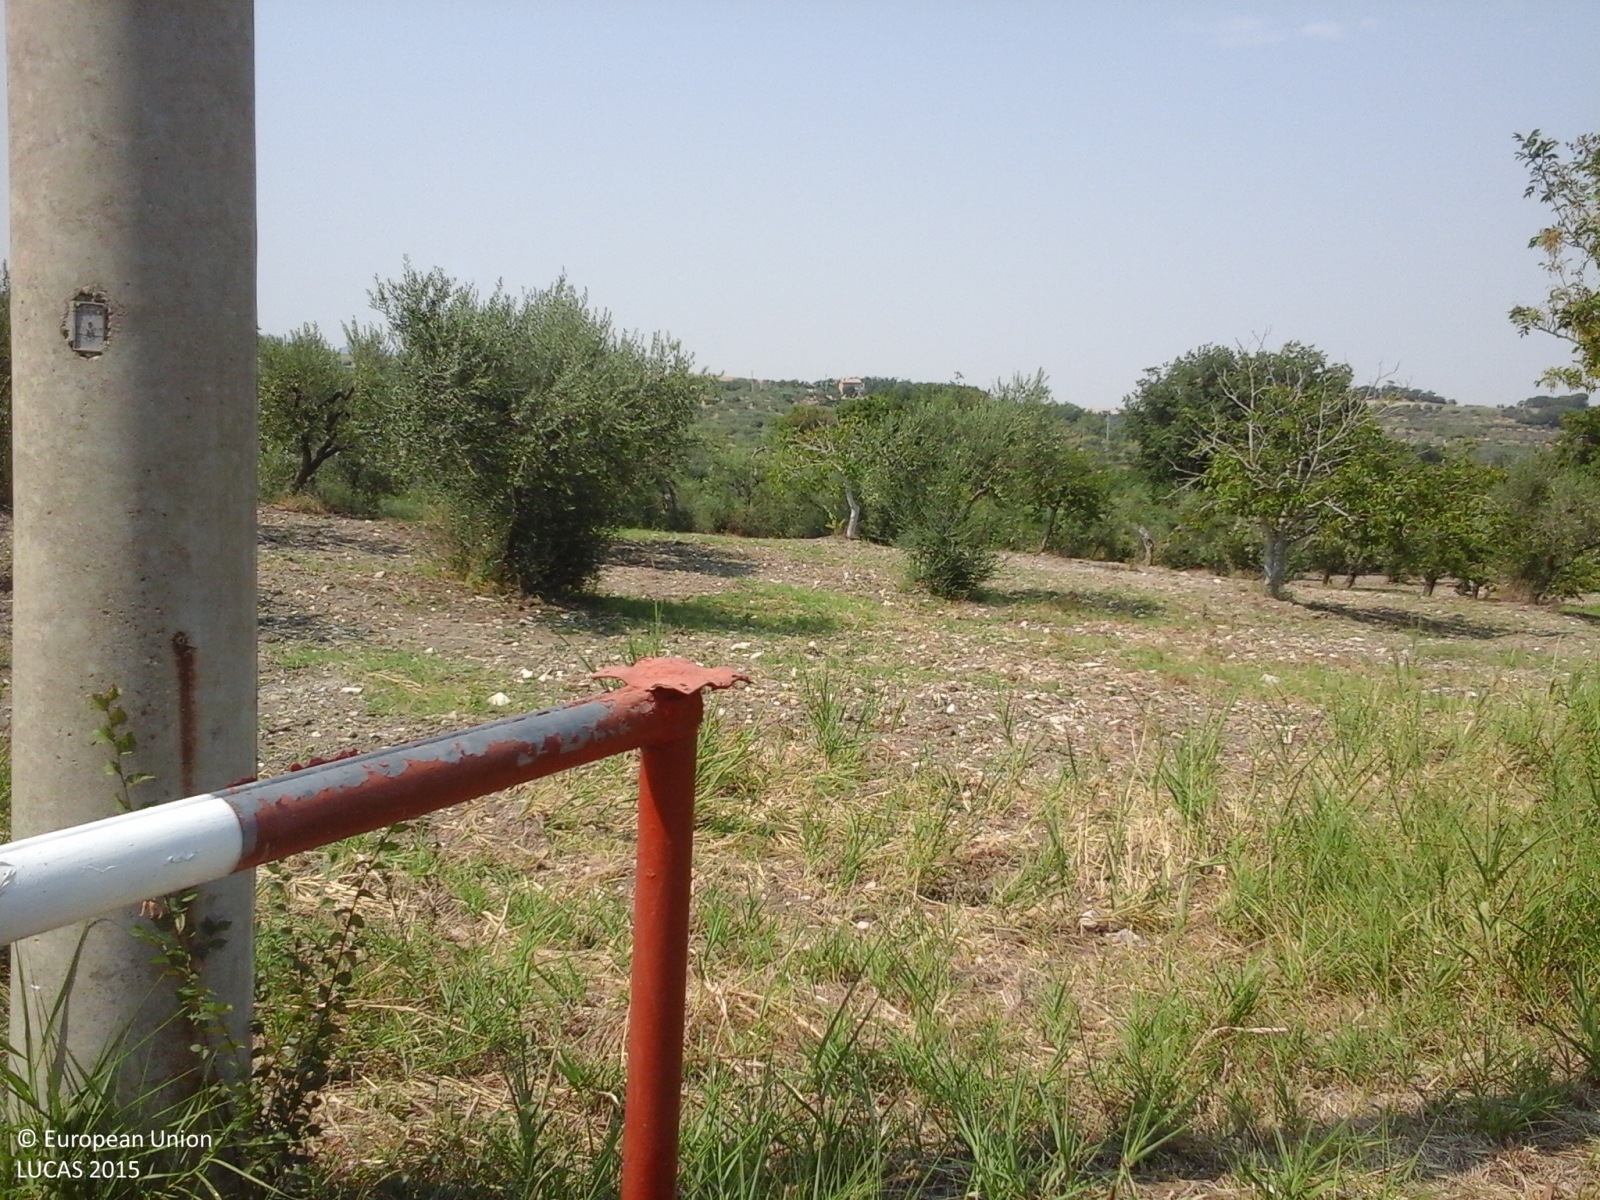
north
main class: Cropland
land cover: Olive groves
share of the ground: 50 - 75 %
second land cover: Spontaneously vegetated surfaces
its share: > 75 %
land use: Agriculture (excluding fallow land and kitchen gardens)
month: August
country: IT
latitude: 41.3988
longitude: 15.1851
